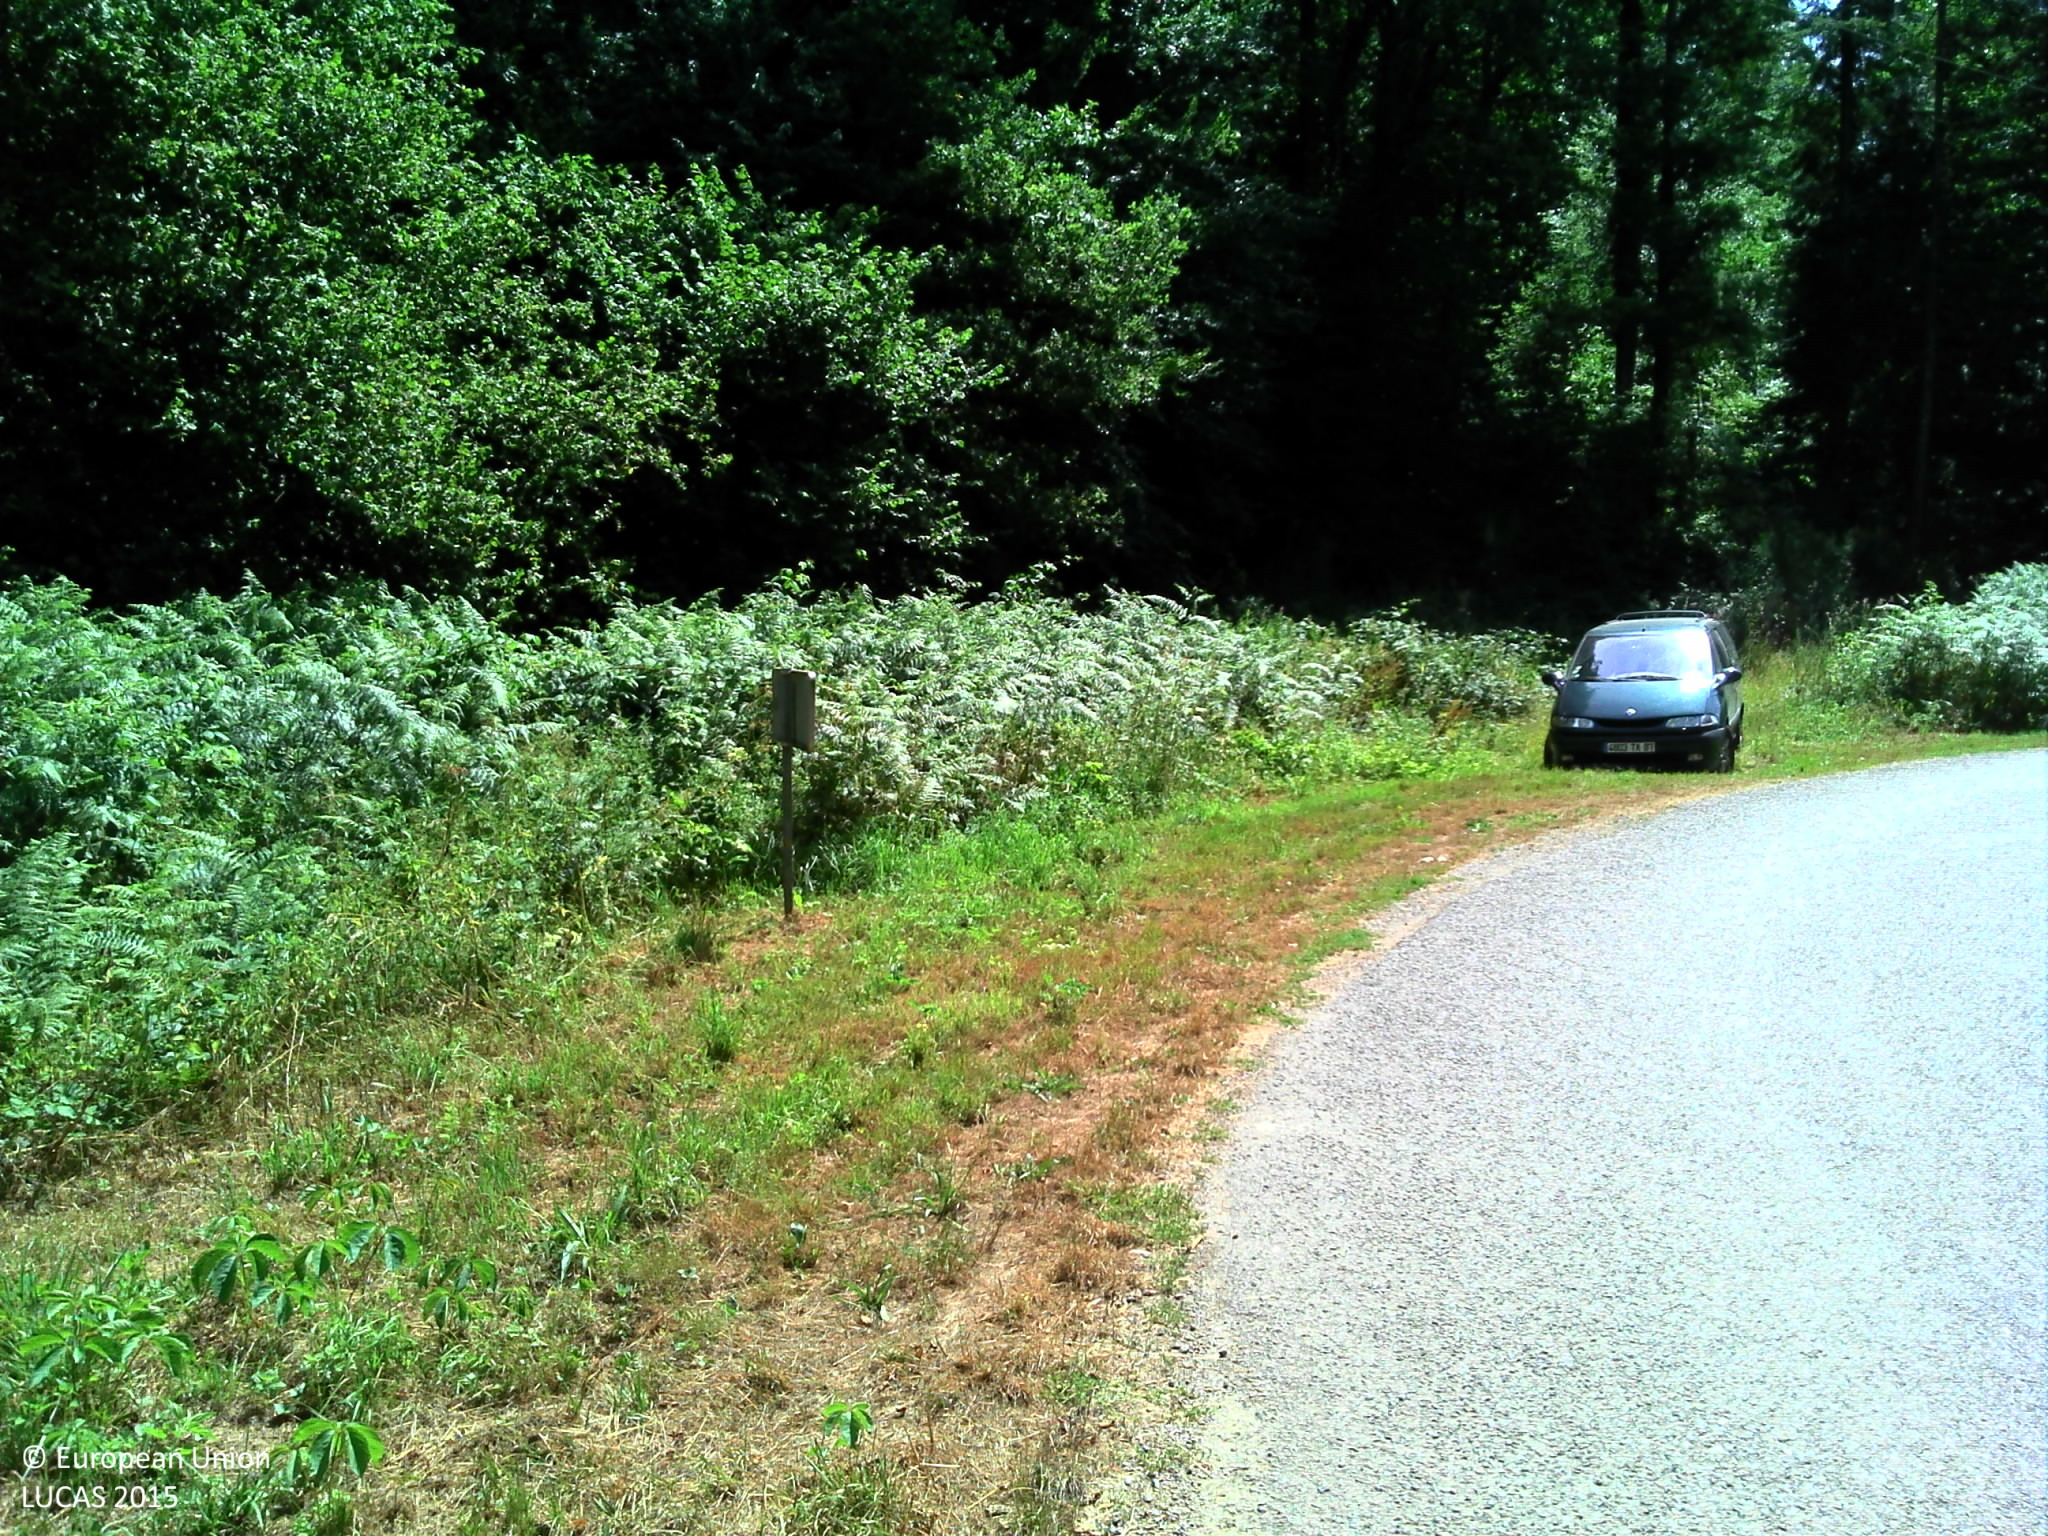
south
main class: Grassland
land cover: Spontaneously vegetated surfaces
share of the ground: > 75 %
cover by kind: herbaceous plants 95 %
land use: Semi-natural and natural areas not in use
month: July
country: FR
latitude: 45.7865
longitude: 1.6193
